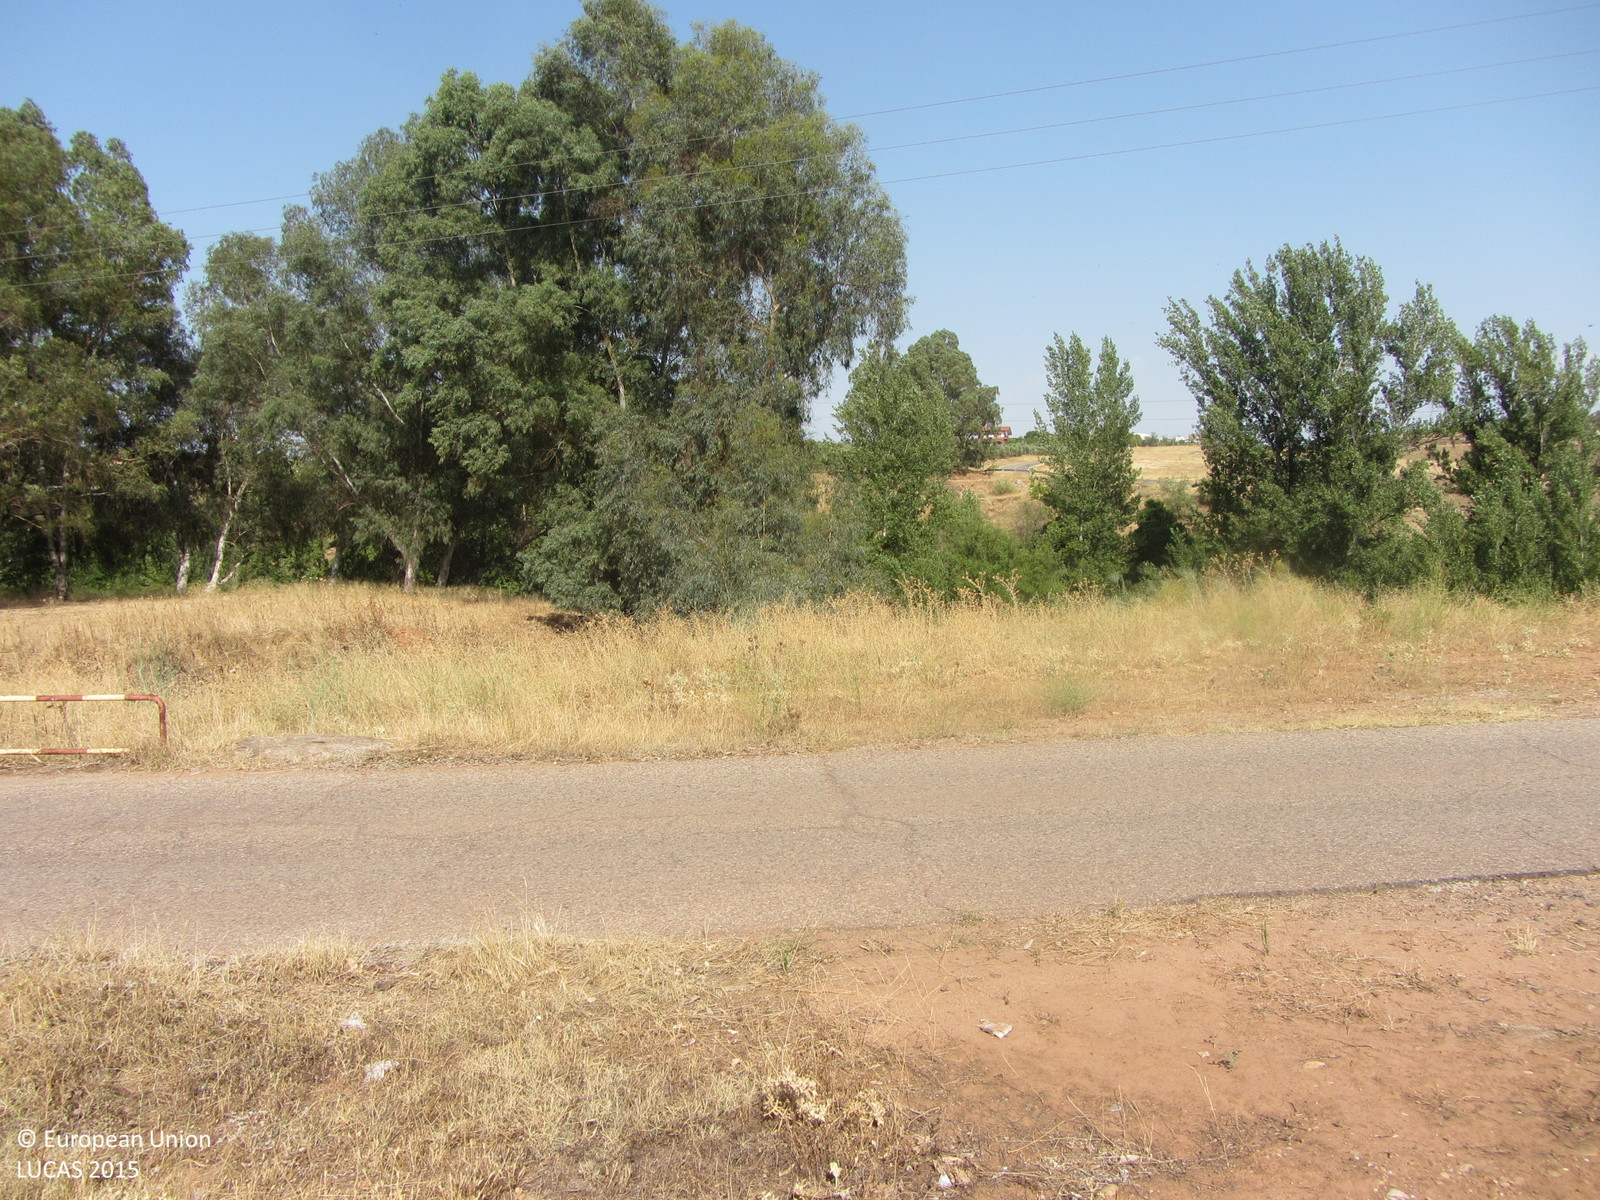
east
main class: Cropland
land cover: Olive groves
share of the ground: 25 - 50 %
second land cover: Spontaneously vegetated surfaces
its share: 10 - 25 %
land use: Agriculture (excluding fallow land and kitchen gardens)
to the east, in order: Olive groves; Spontaneously vegetated surfaces; Fences; Tracks; Grassland without tree/shrub cover; Paved roads, cycling and walking lanes; Electric lines; Grassland without tree/shrub cover; Shruby margins; Spontaneously vegetated surfaces; Shruby margins; Spontaneously vegetated surfaces; Broadleaved woodland; Inland fresh running water; Broadleaved woodland; Shrubland with sparse tree cover; Tracks; Shrubland with sparse tree cover
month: July
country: ES
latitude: 38.0896
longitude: -3.8365
